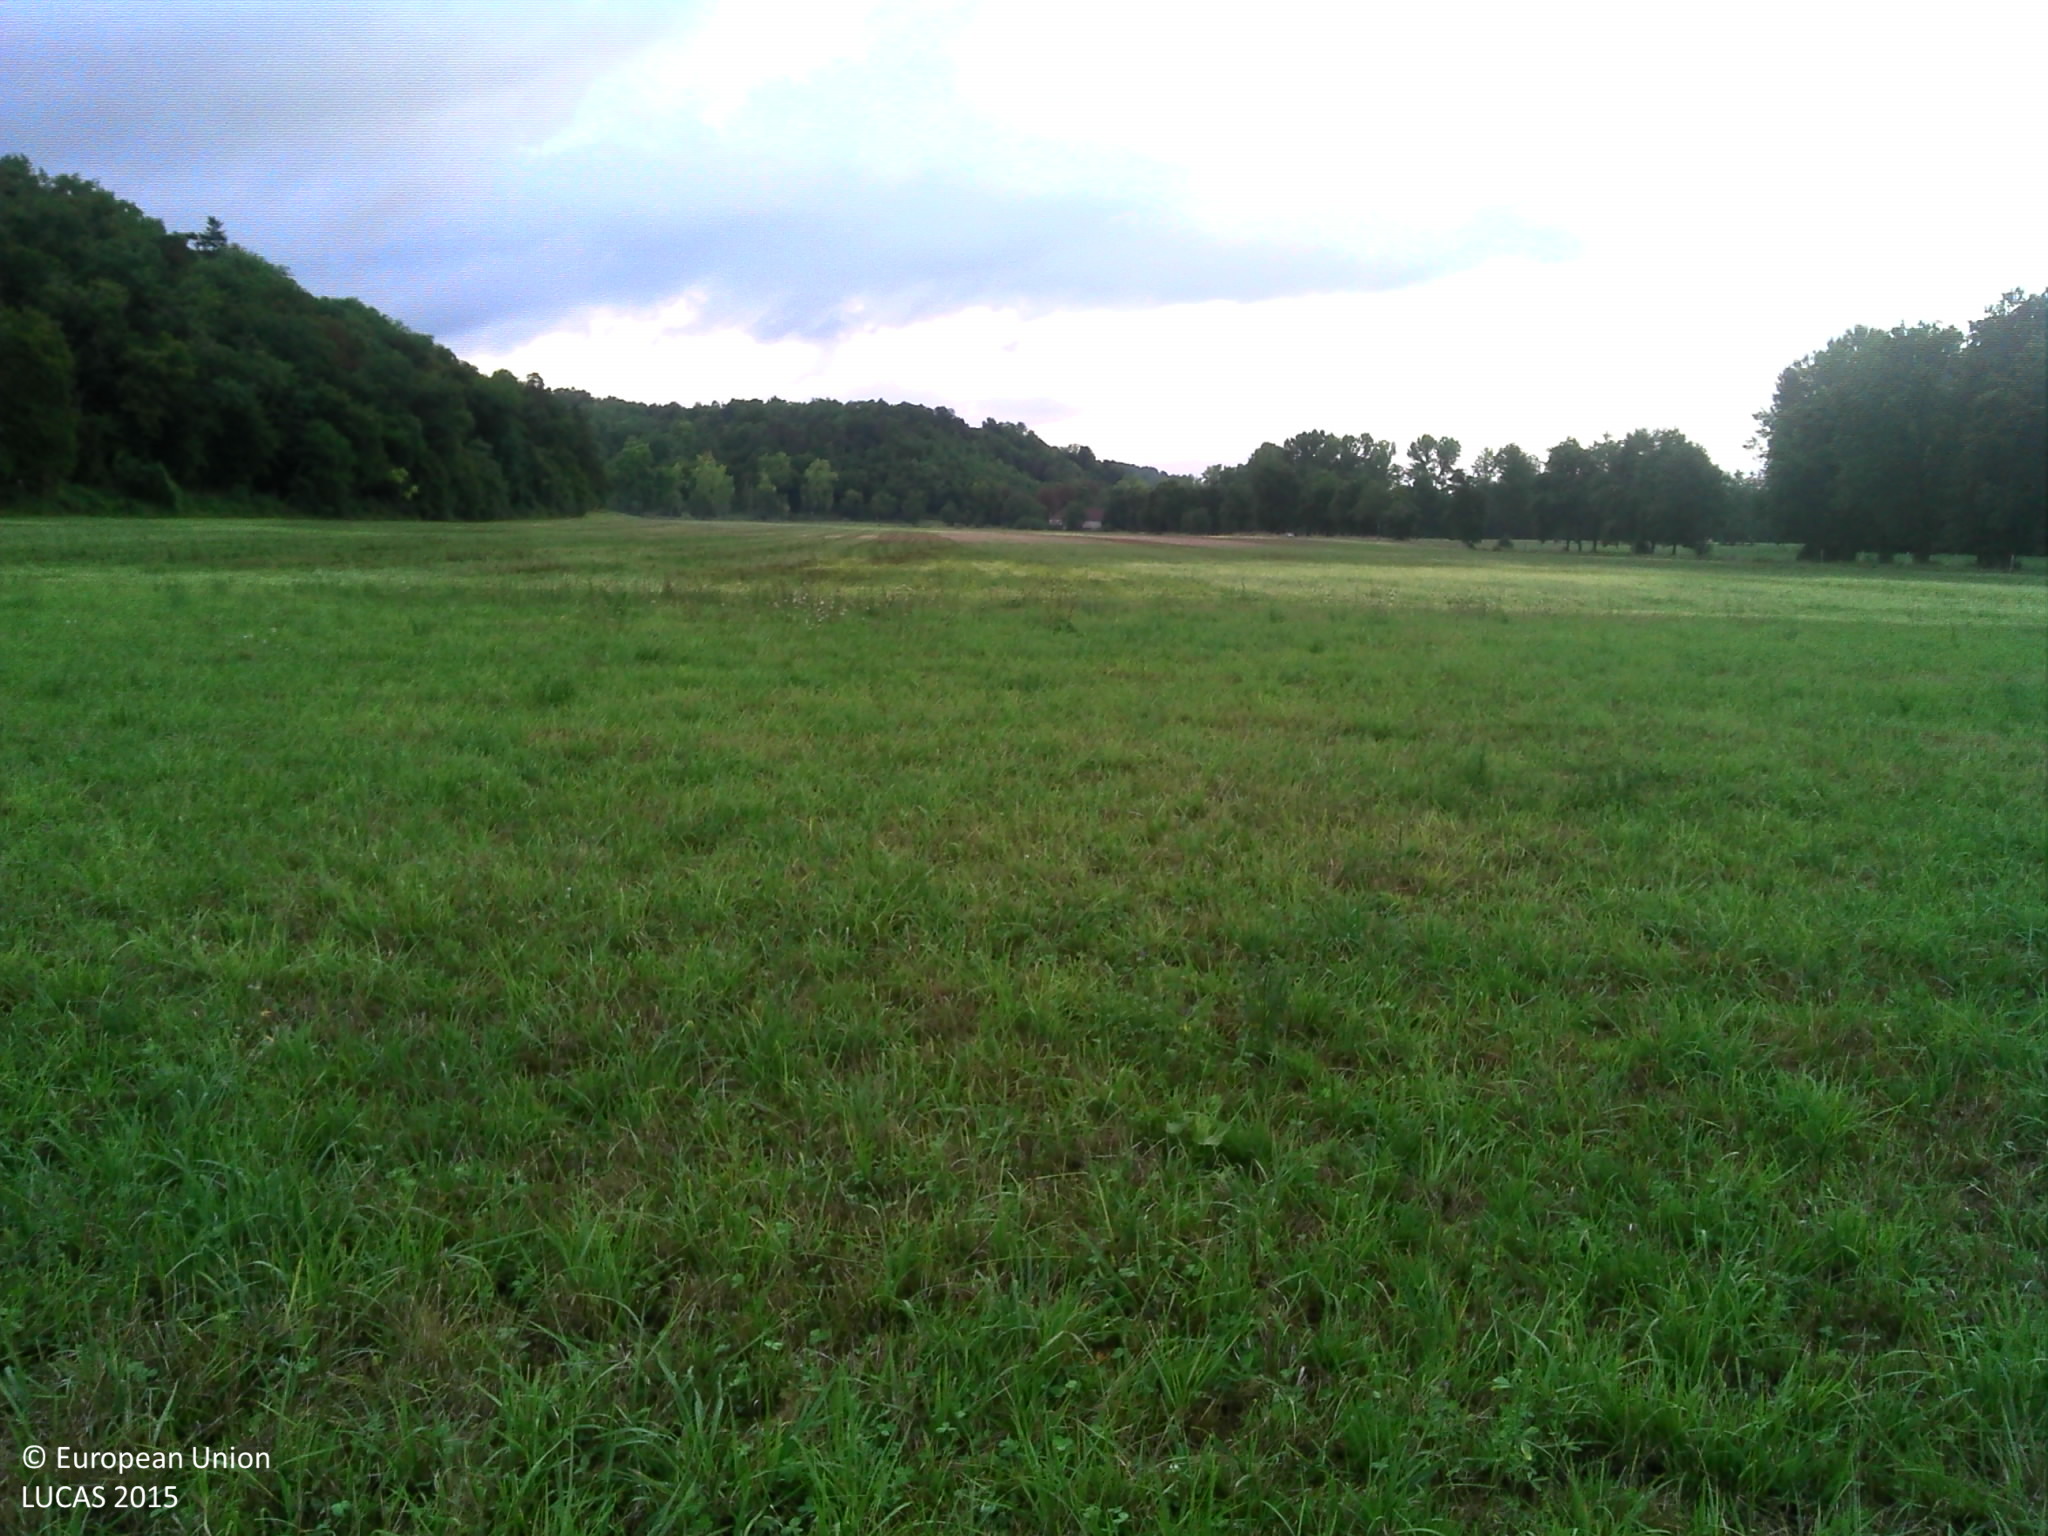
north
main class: Grassland
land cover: Grassland without tree/shrub cover
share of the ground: > 75 %
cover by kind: herbaceous plants 100 %
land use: Agriculture (excluding fallow land and kitchen gardens)
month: August
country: FR
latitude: 45.4194
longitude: 0.6982
